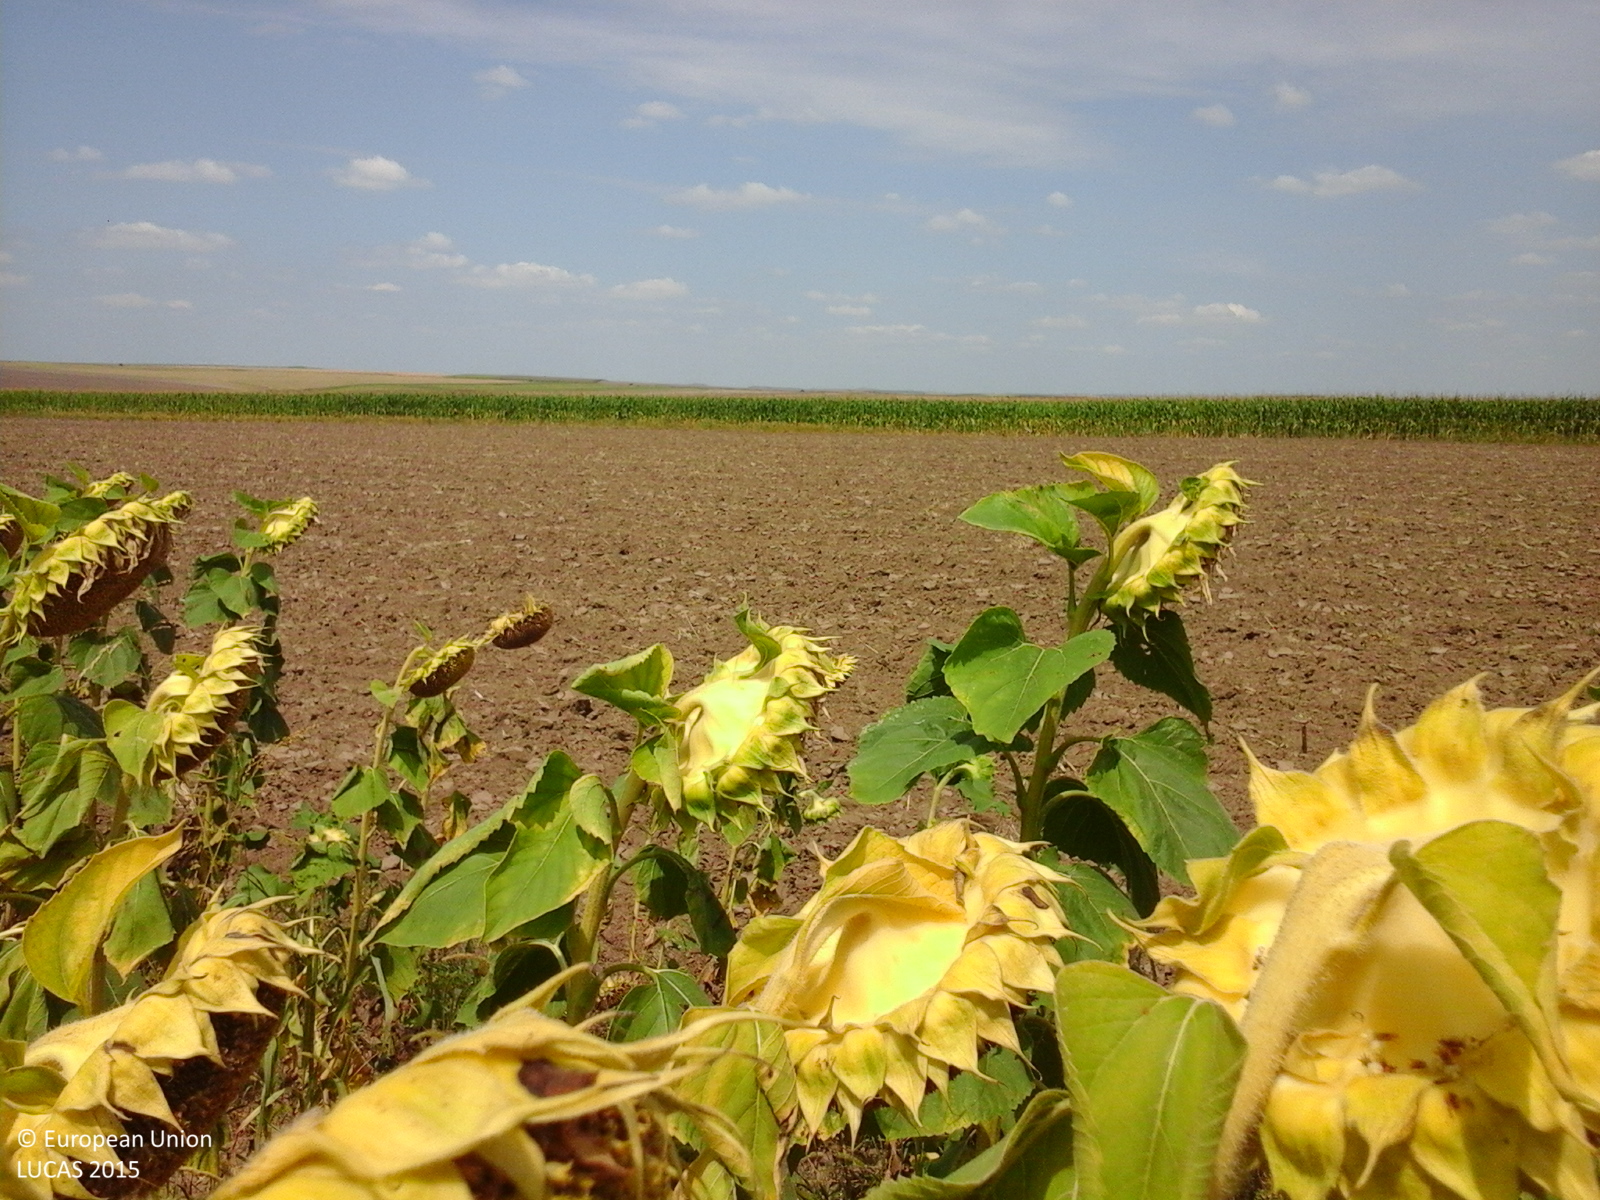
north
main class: Cropland
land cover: Sunflower
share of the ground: > 75 %
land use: Agriculture (excluding fallow land and kitchen gardens)
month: August
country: RO
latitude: 44.7945
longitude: 28.1800
